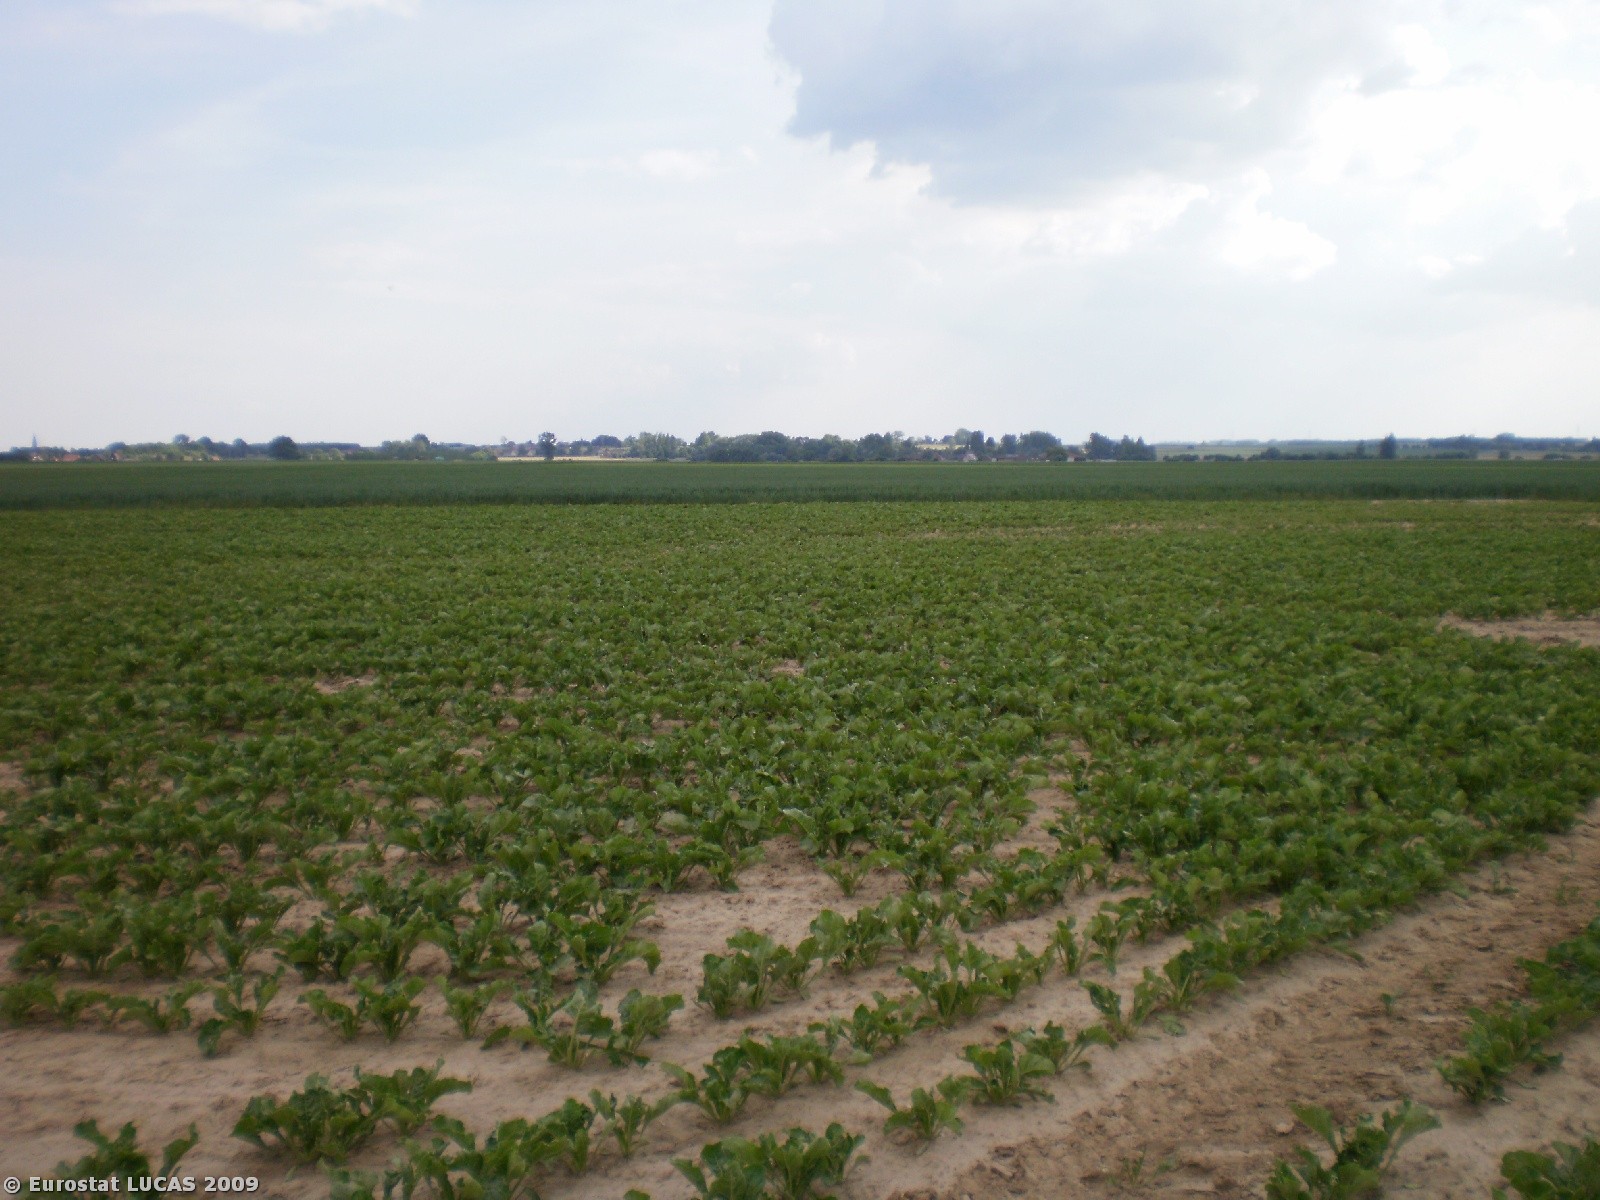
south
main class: Cropland
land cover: Sugar beet
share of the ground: 50 - 75 %
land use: Agriculture (excluding fallow land and kitchen gardens)
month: June
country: BE
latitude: 50.5743
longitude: 3.7945
